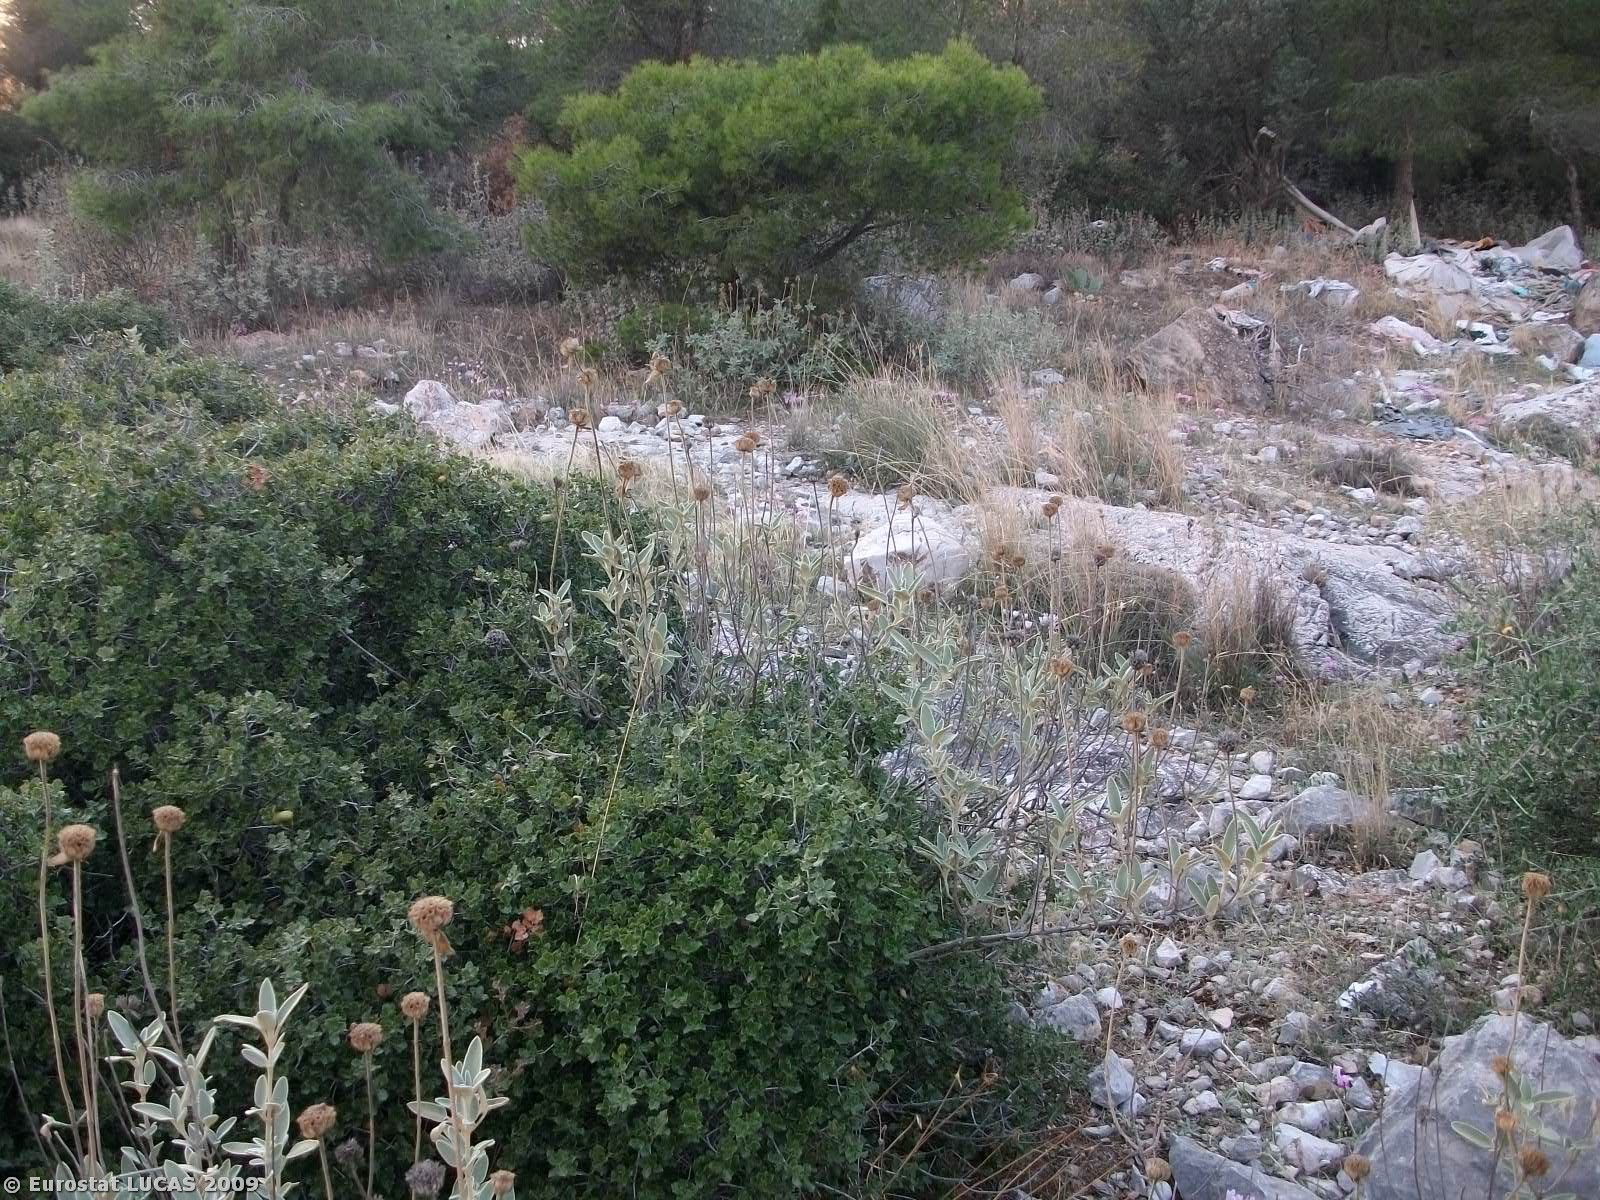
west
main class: Grassland
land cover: Grassland with sparse tree/shrub cover
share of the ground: > 75 %
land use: Unused
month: October
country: GR
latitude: 38.0556
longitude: 23.6913
